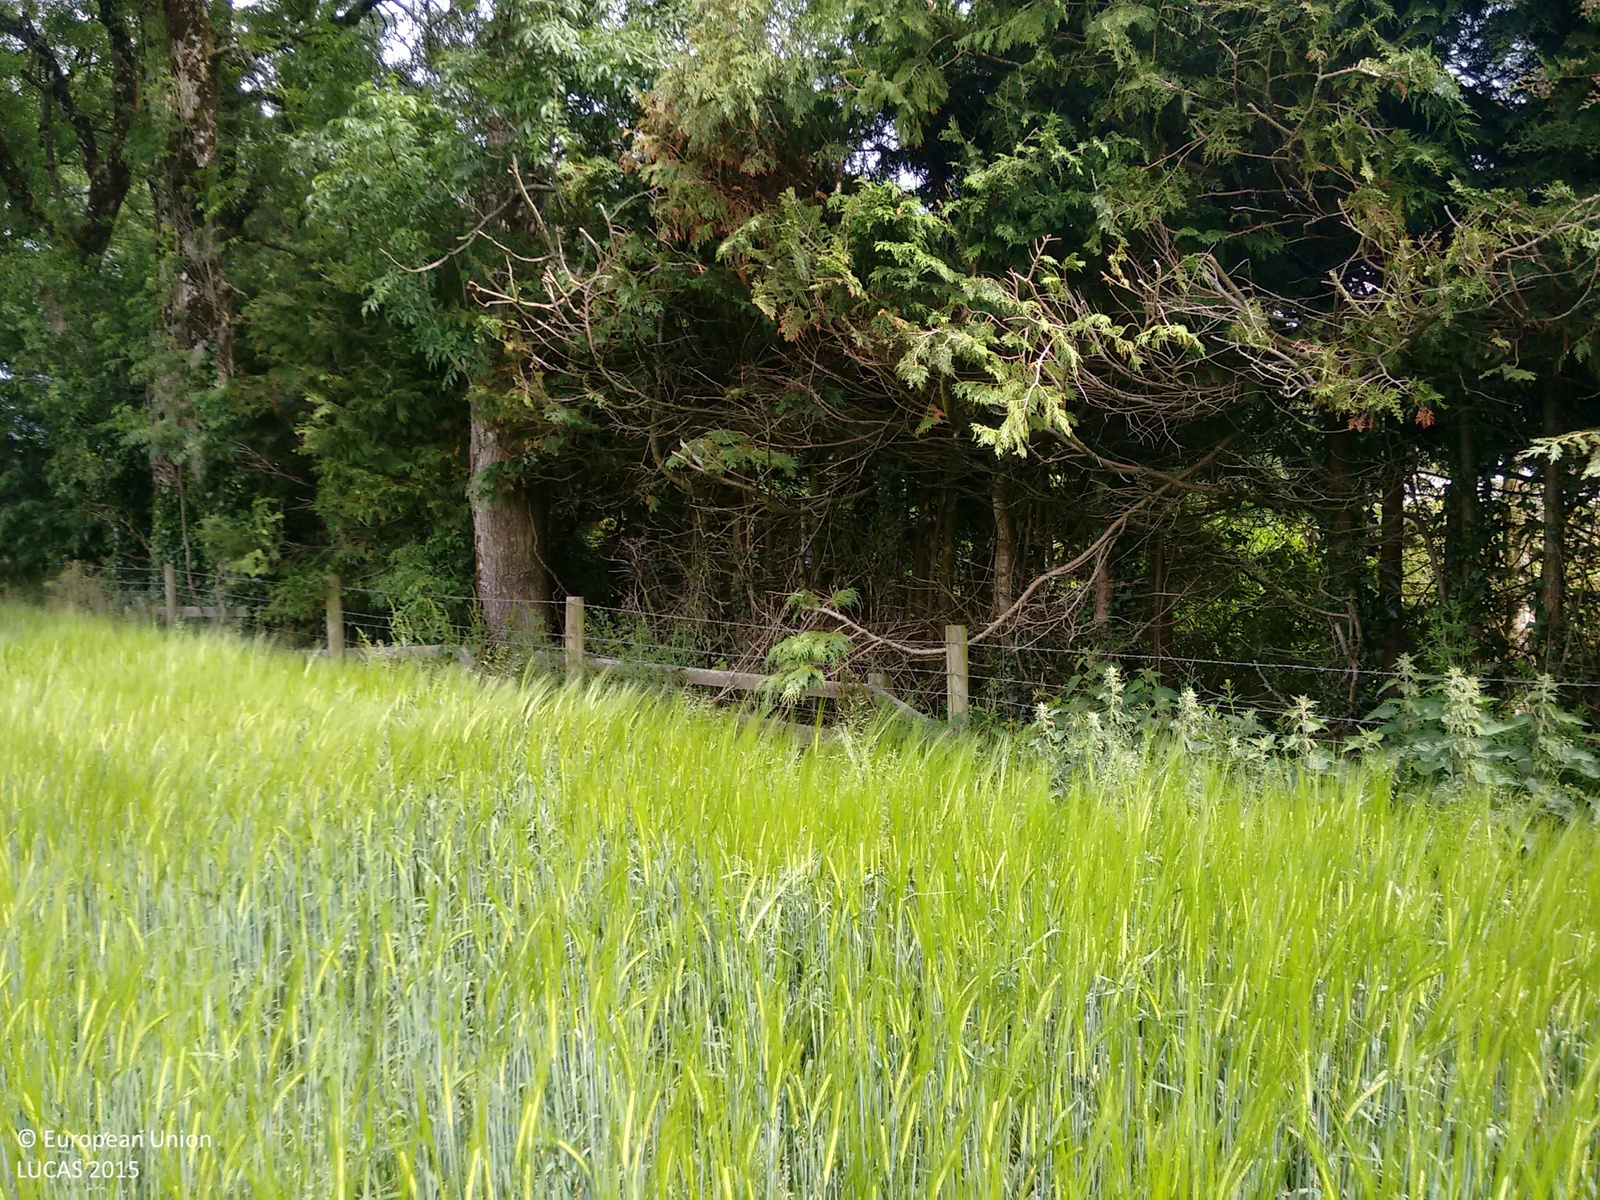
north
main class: Cropland
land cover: Barley
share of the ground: > 75 %
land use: Agriculture (excluding fallow land and kitchen gardens)
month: July
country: GB
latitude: 54.5523
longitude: -7.3272
